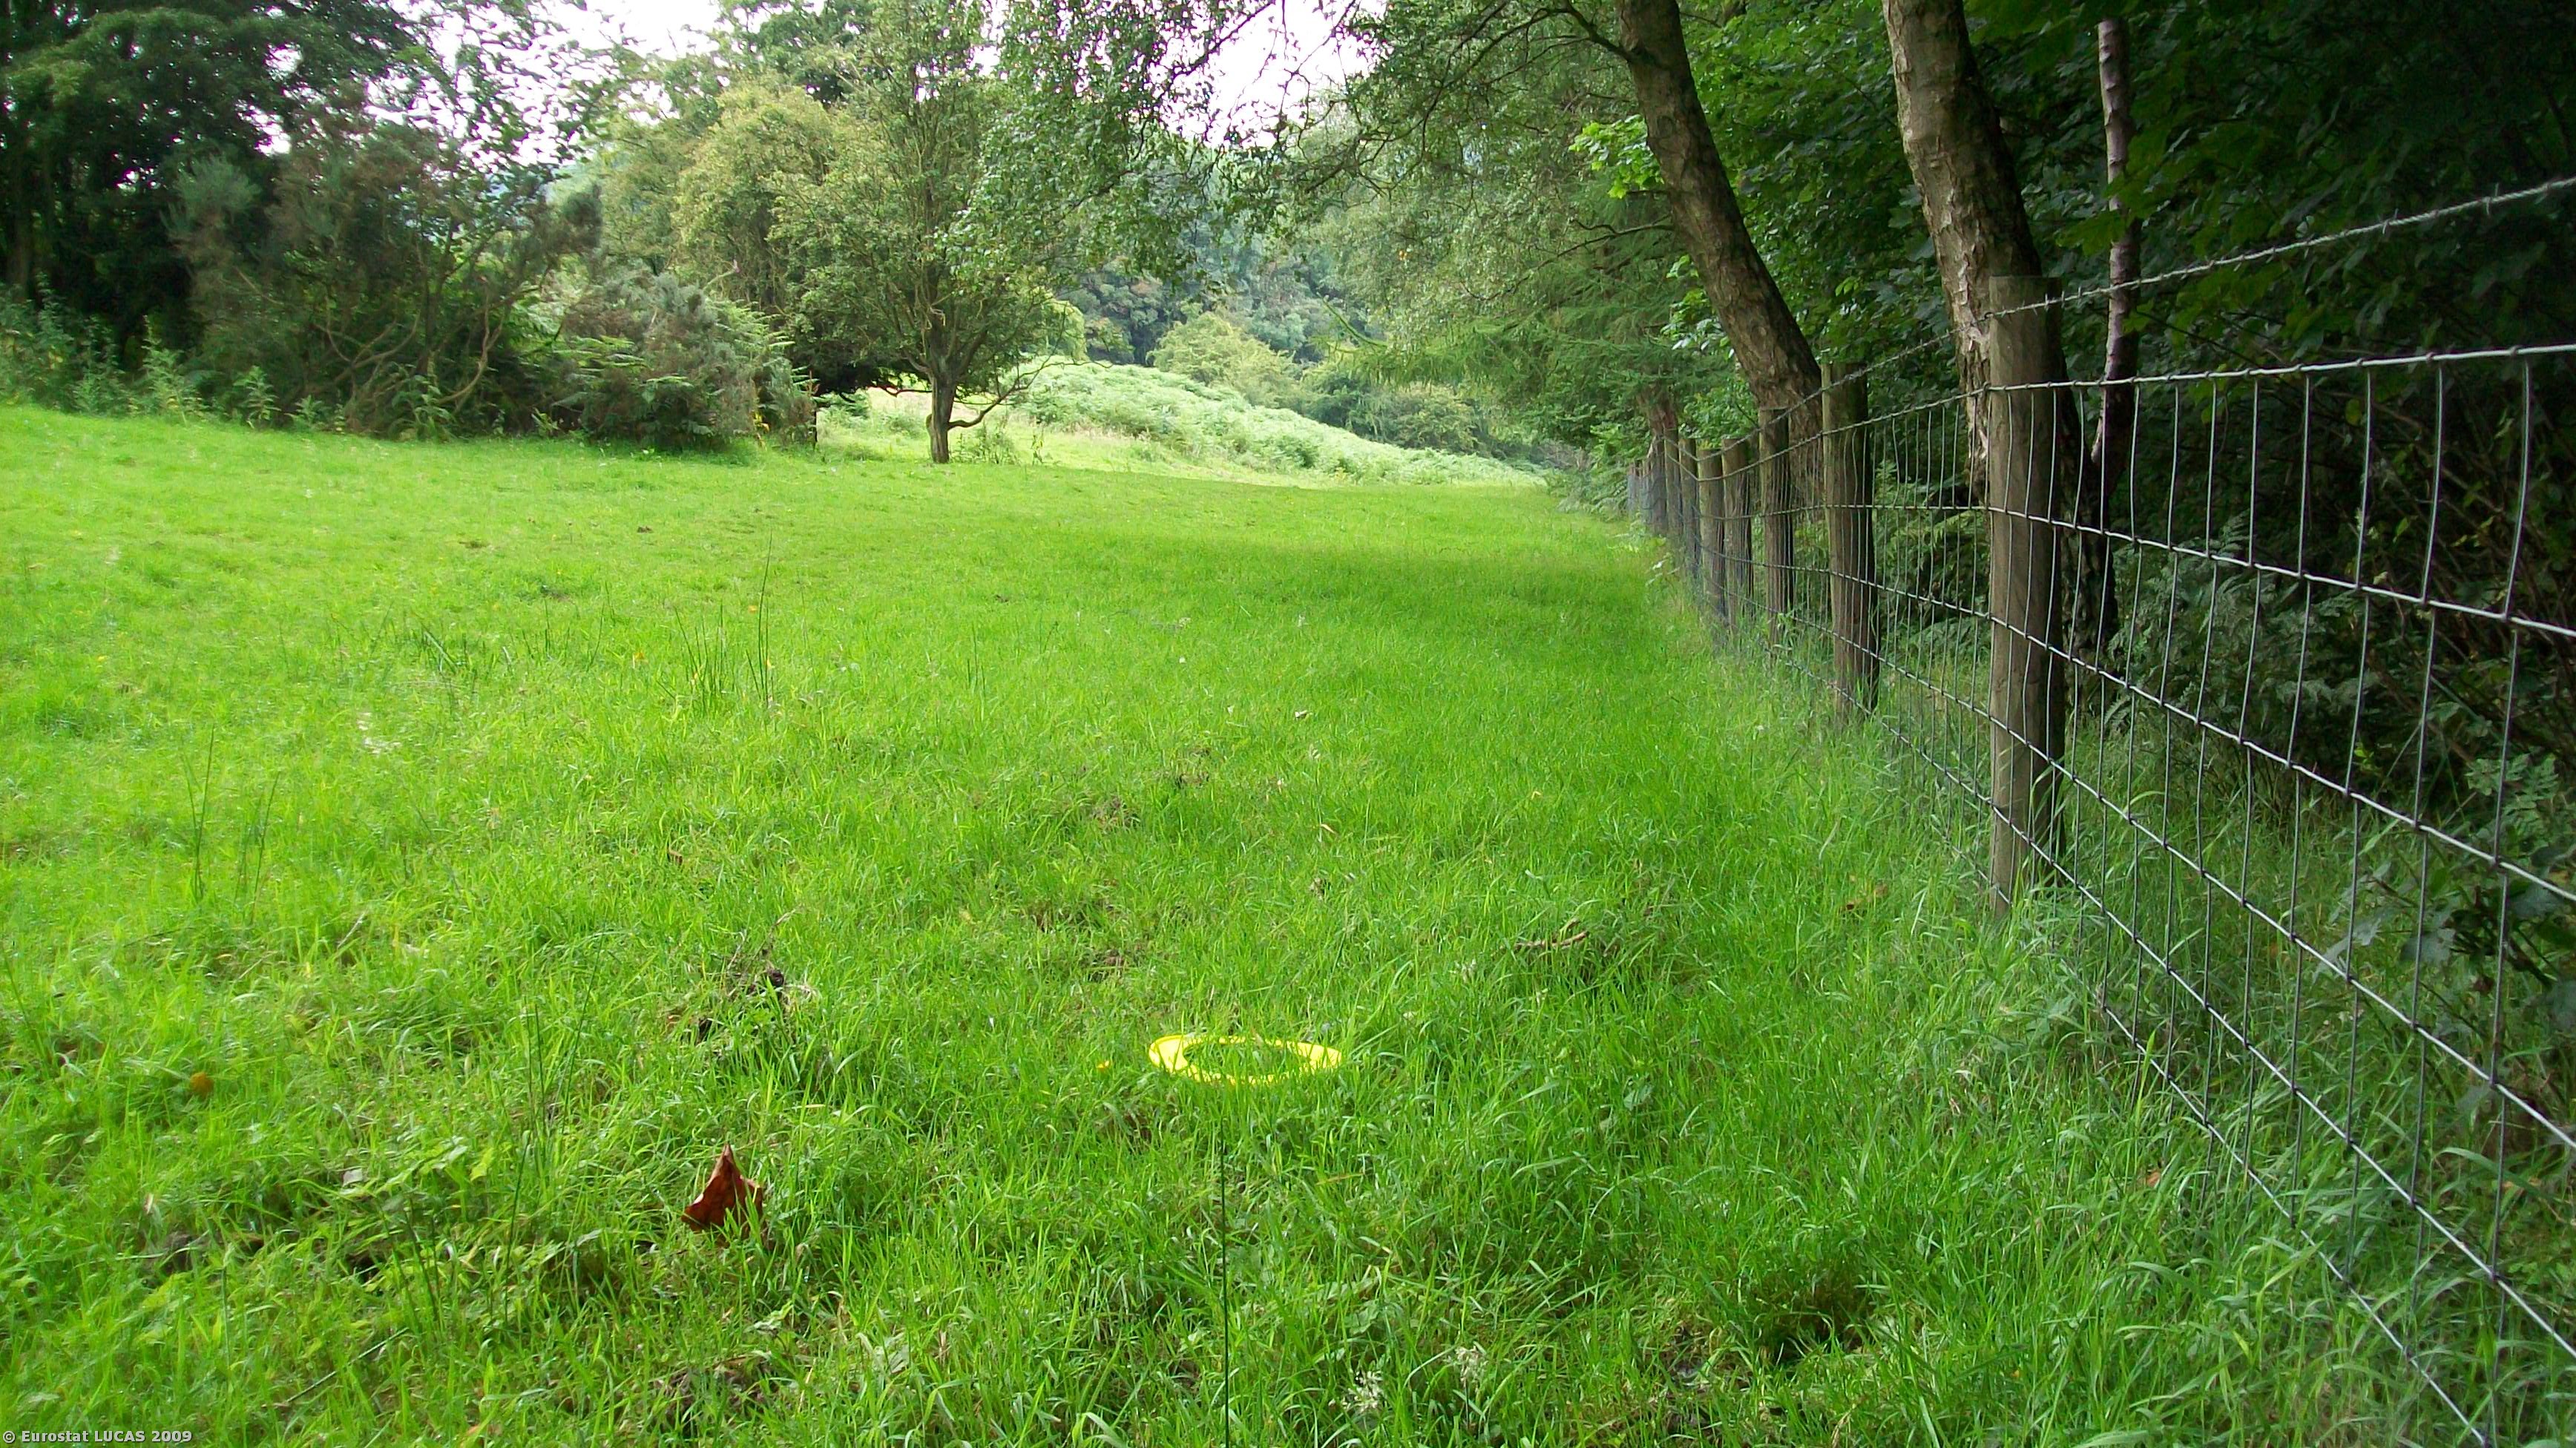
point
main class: Woodland
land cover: Mixed woodland
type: hemiboreal forest and nemoral coniferous forest and mixed broadleaved-coniferous forest
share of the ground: > 75 %
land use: Forestry
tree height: > 5 m
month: August
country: GB
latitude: 54.2098
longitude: -1.1607
